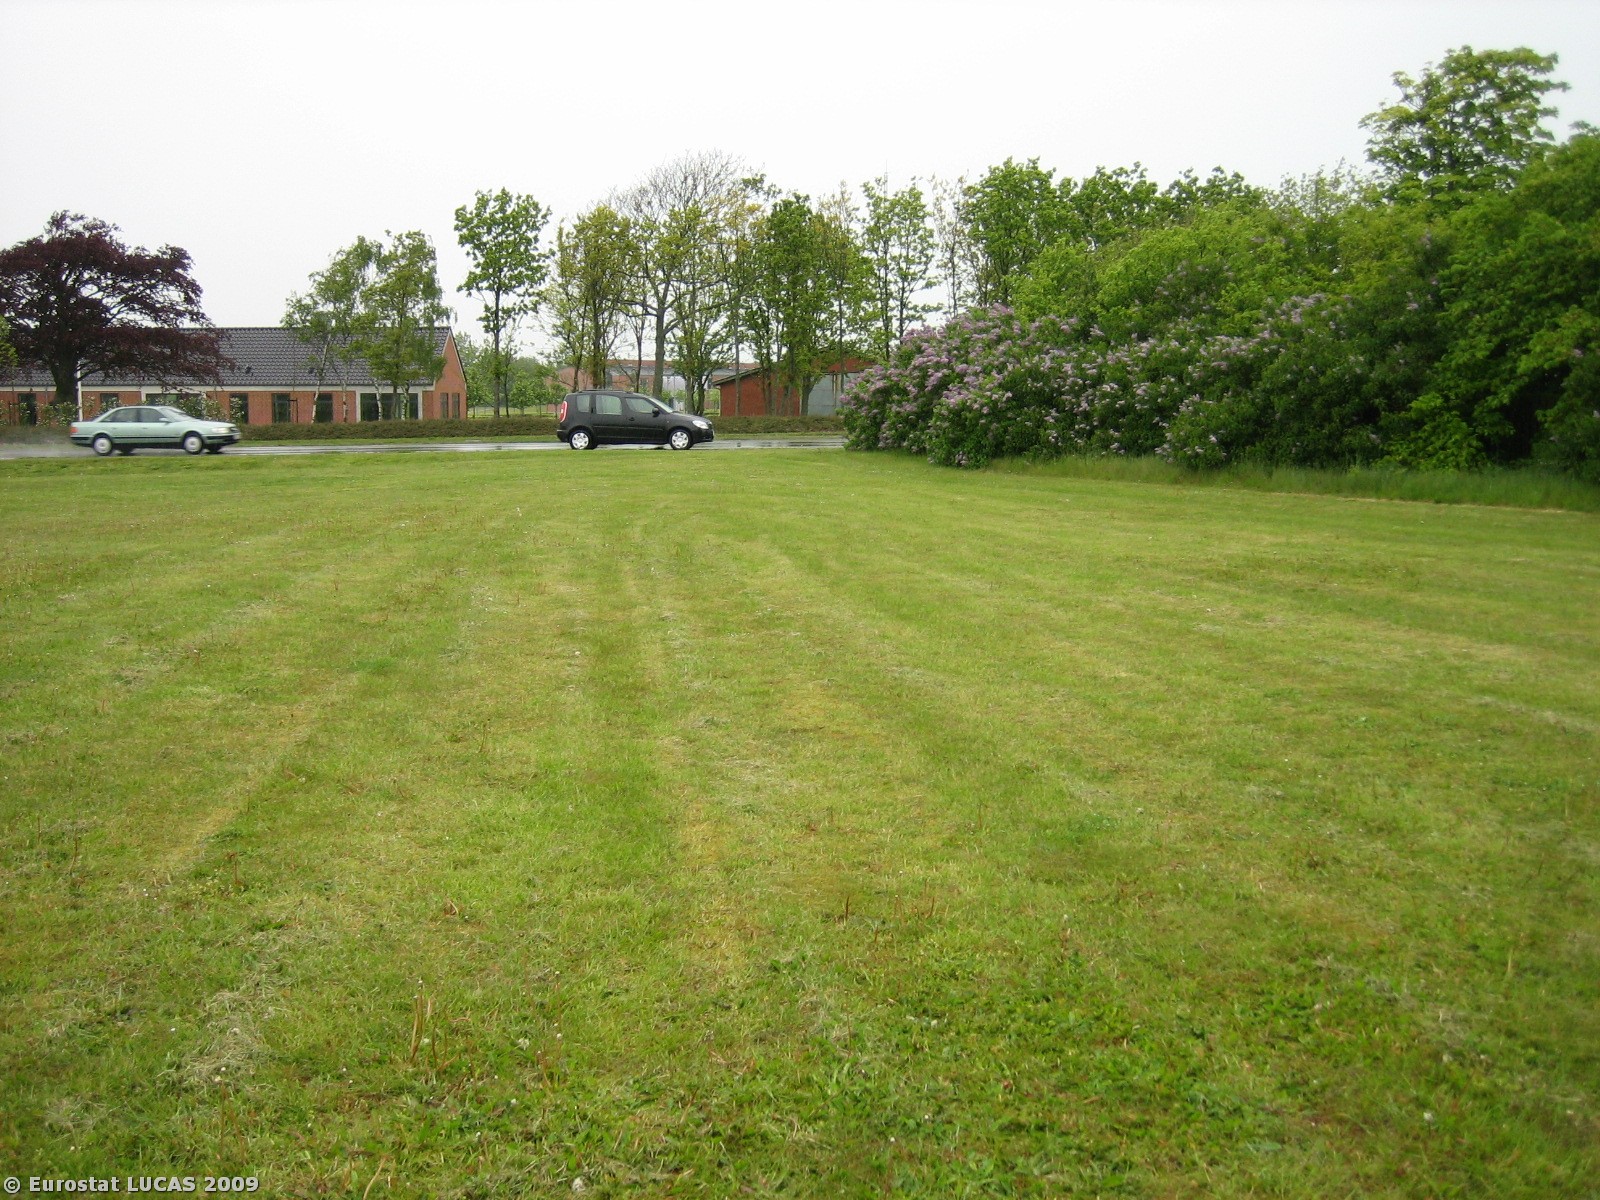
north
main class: Grassland
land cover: Grassland without tree/shrub cover
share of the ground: > 75 %
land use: Commerce, finance, business
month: May
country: DK
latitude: 56.0864
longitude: 8.2823
